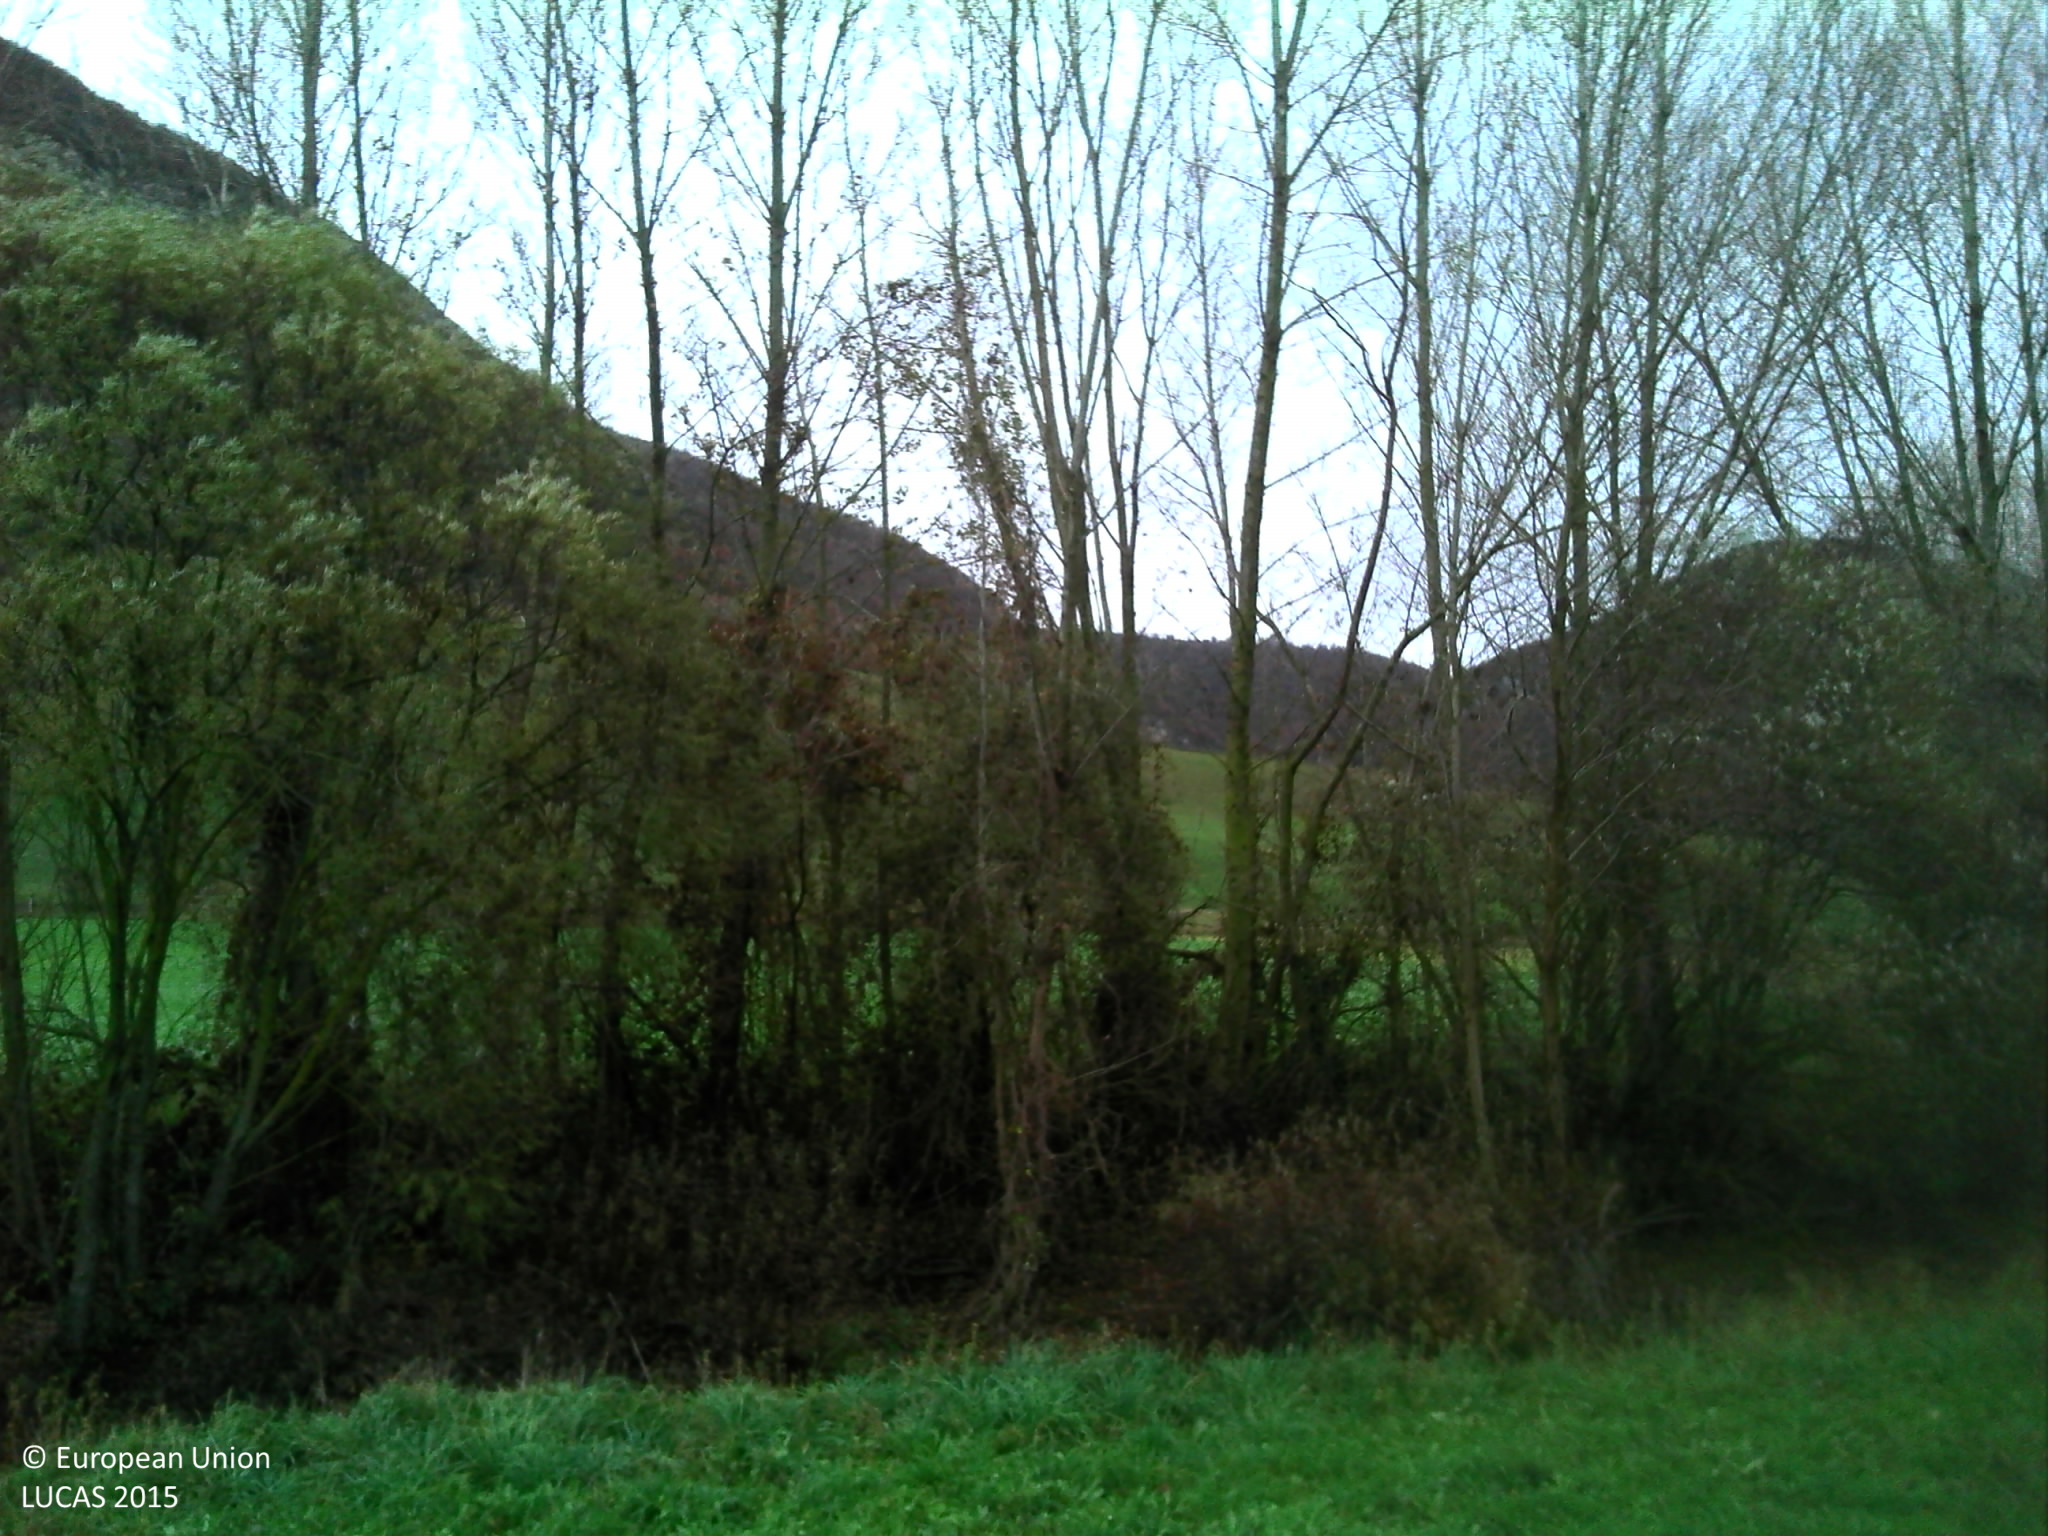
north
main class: Cropland
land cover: Temporary grasslands
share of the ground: > 75 %
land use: Agriculture (excluding fallow land and kitchen gardens)
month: November
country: FR
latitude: 44.0420
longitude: 3.0048
